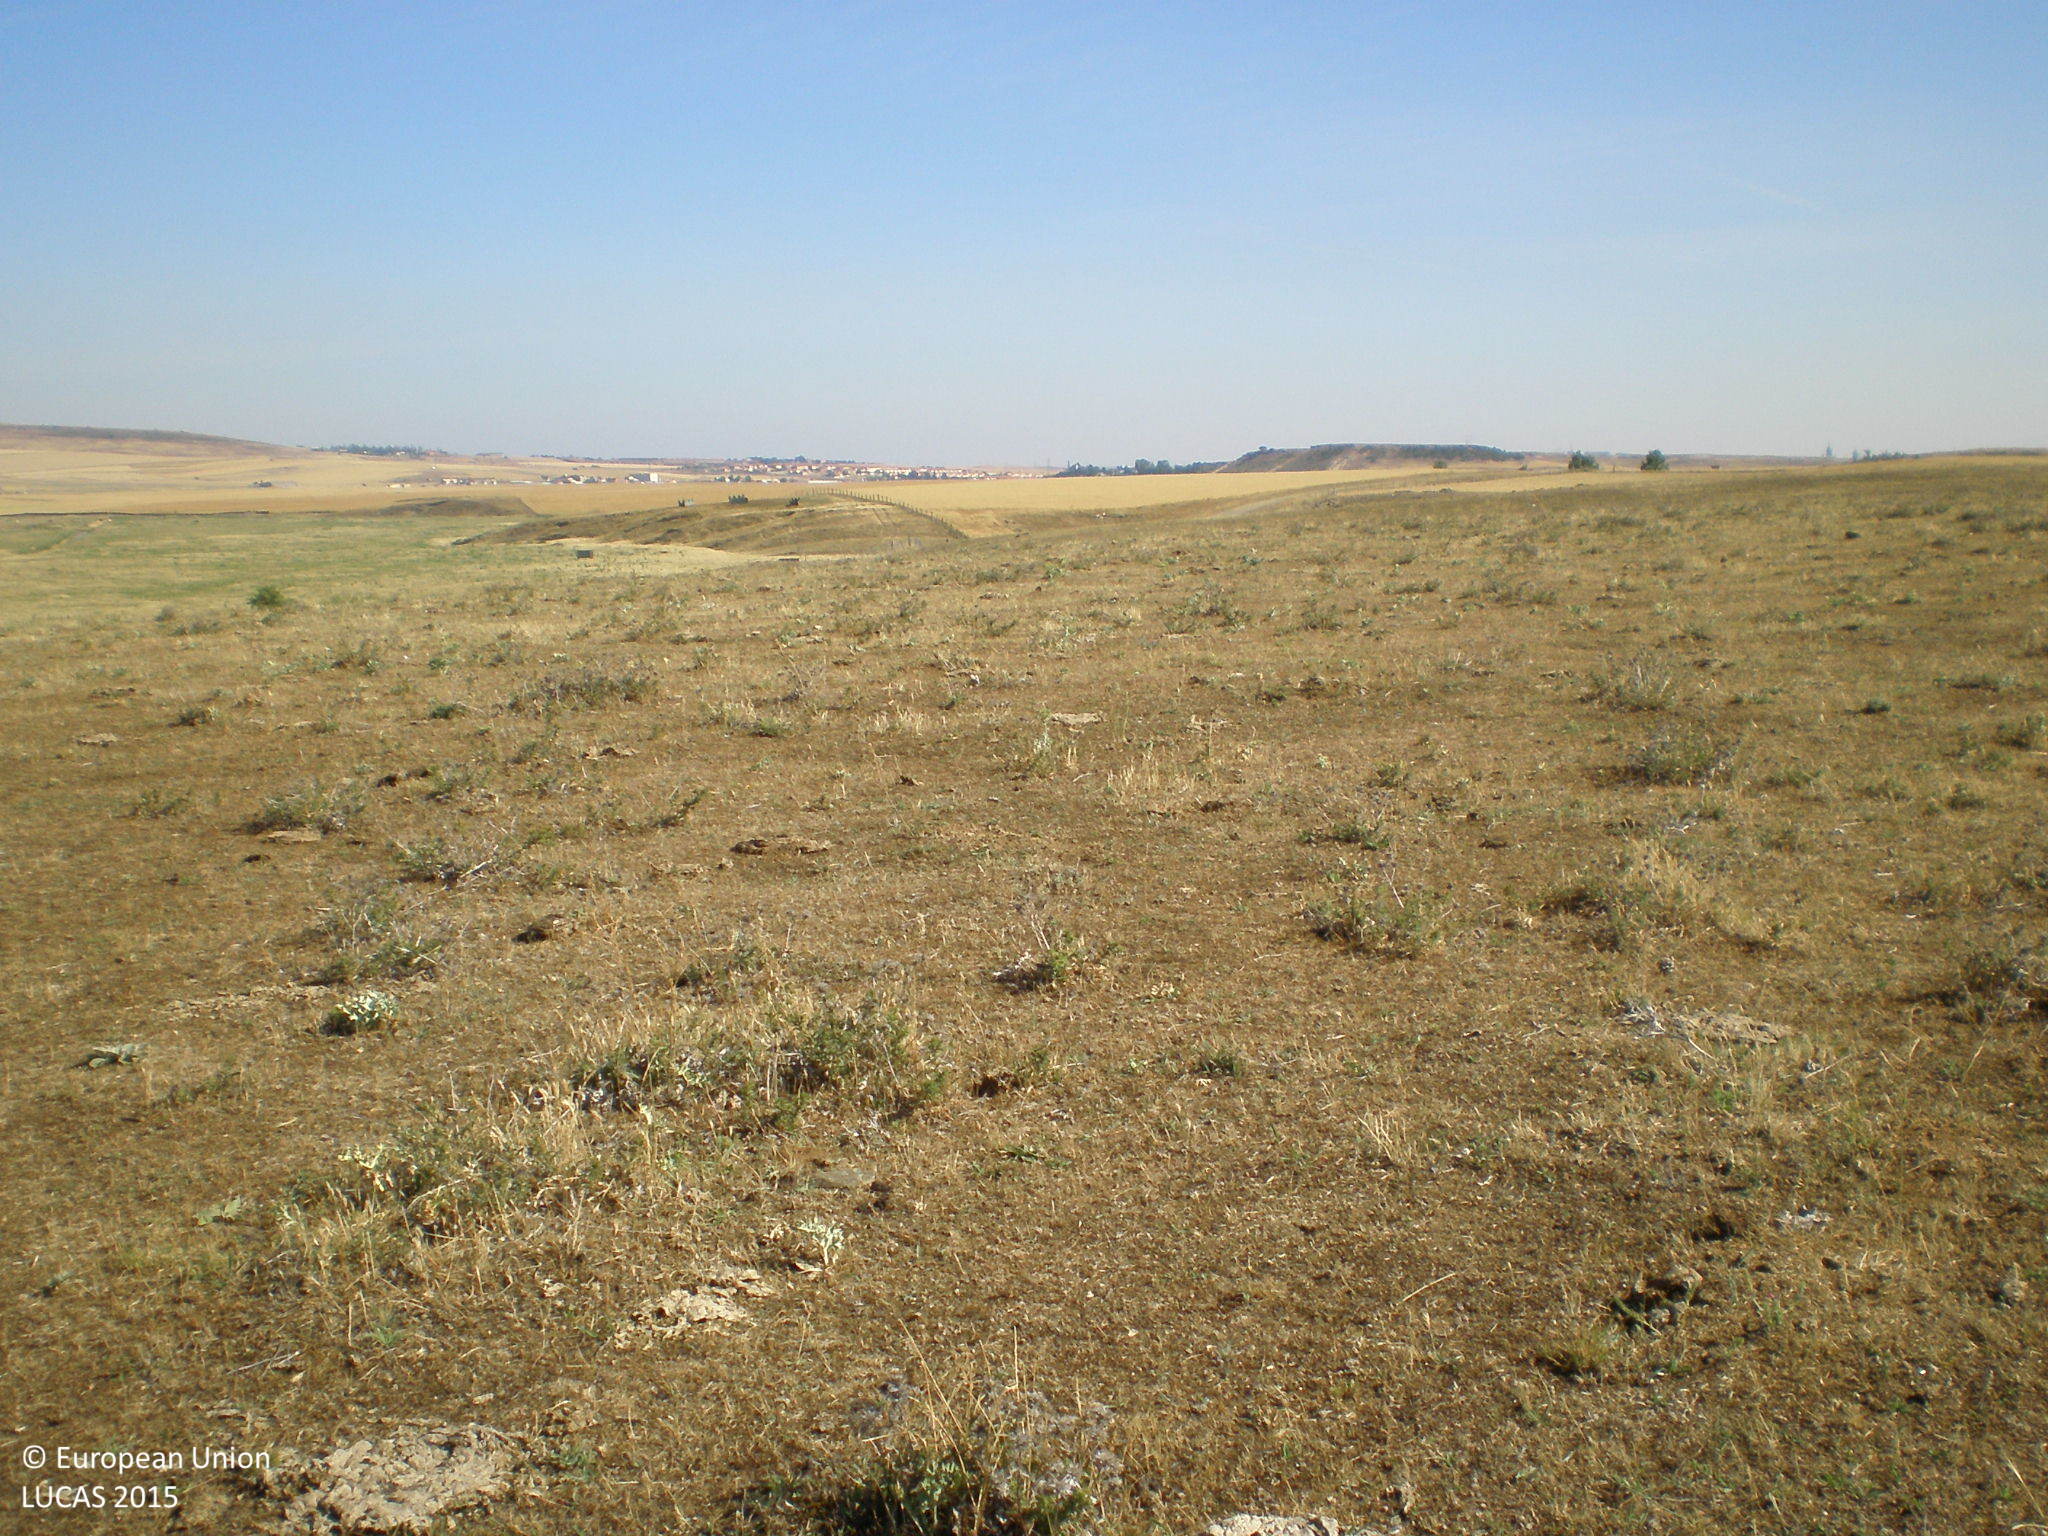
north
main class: Grassland
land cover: Grassland without tree/shrub cover
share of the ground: > 75 %
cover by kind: herbaceous plants 100 %
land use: Agriculture (excluding fallow land and kitchen gardens)
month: June
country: ES
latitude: 40.8906
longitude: -5.6841
